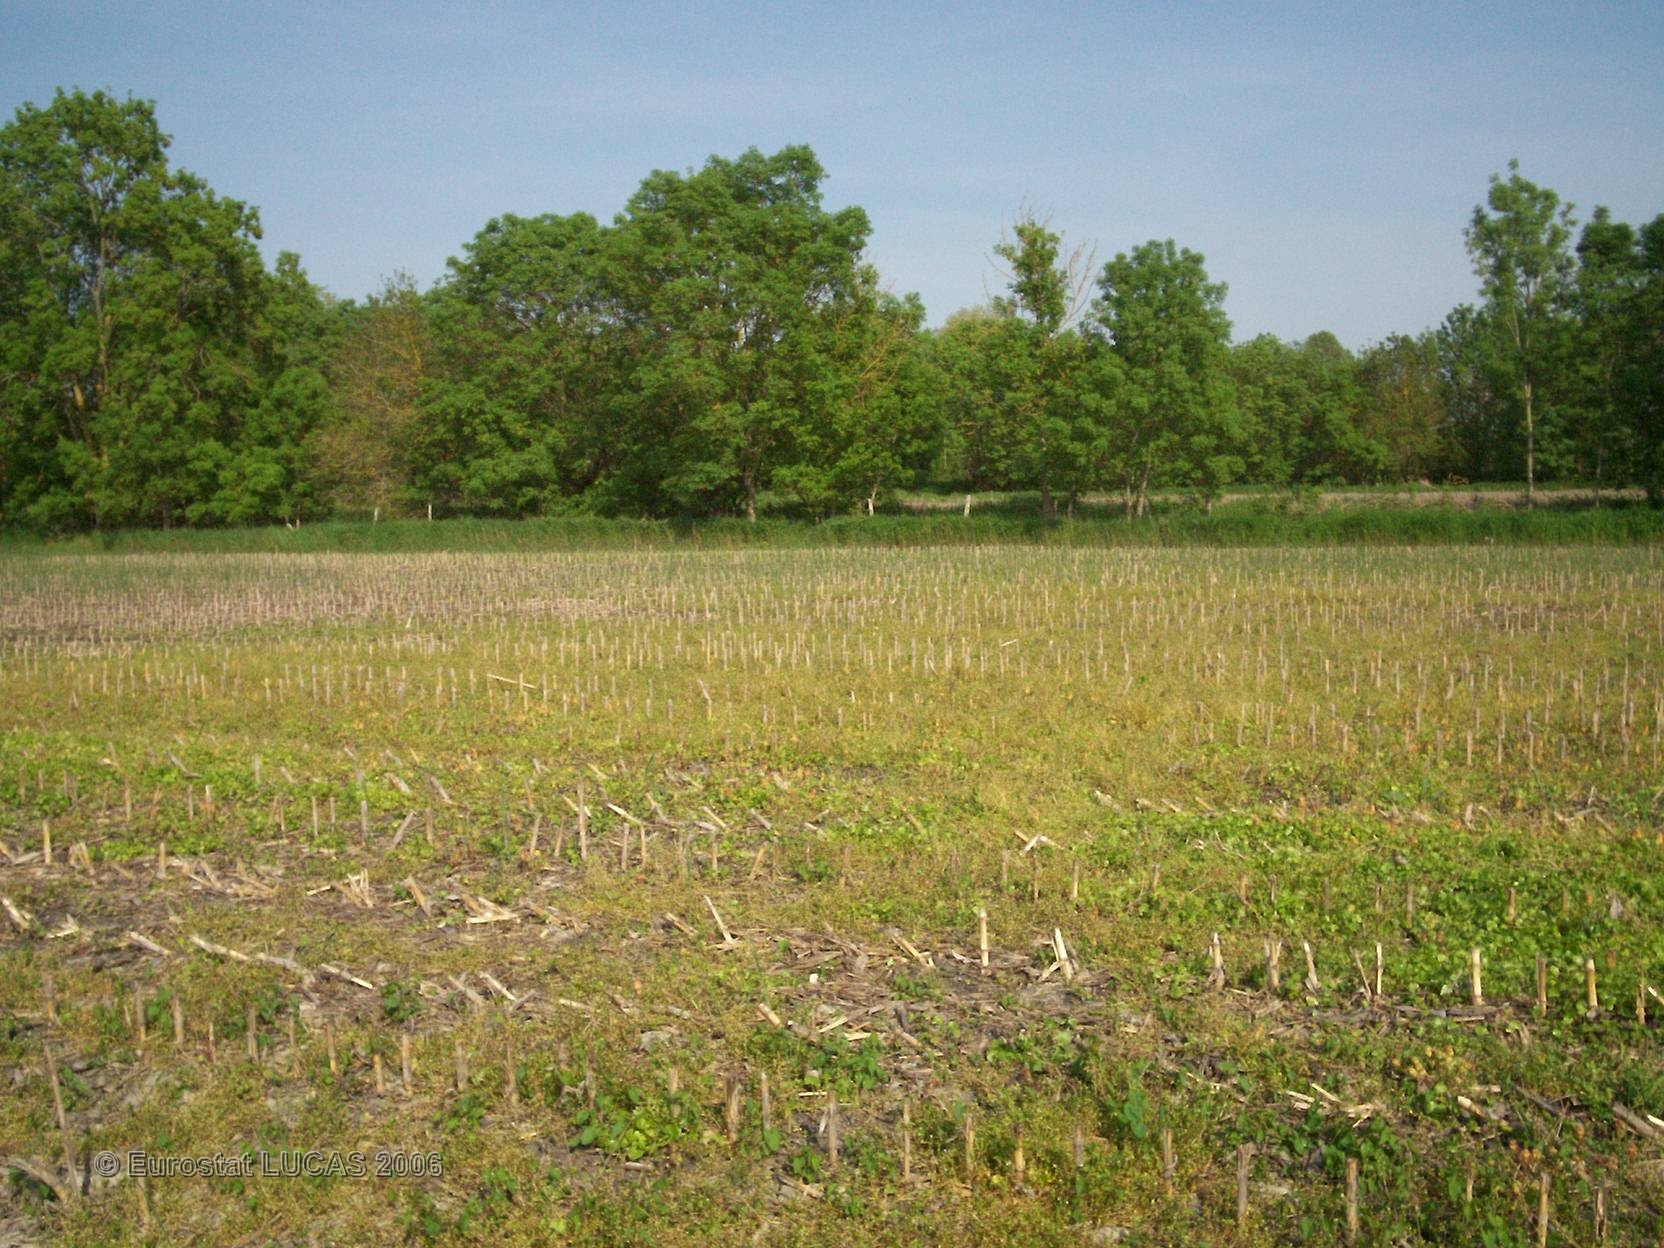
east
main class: Cropland
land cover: Maize
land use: Agriculture (excluding fallow land and kitchen gardens)
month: May
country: FR
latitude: 46.2460
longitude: -0.7279
